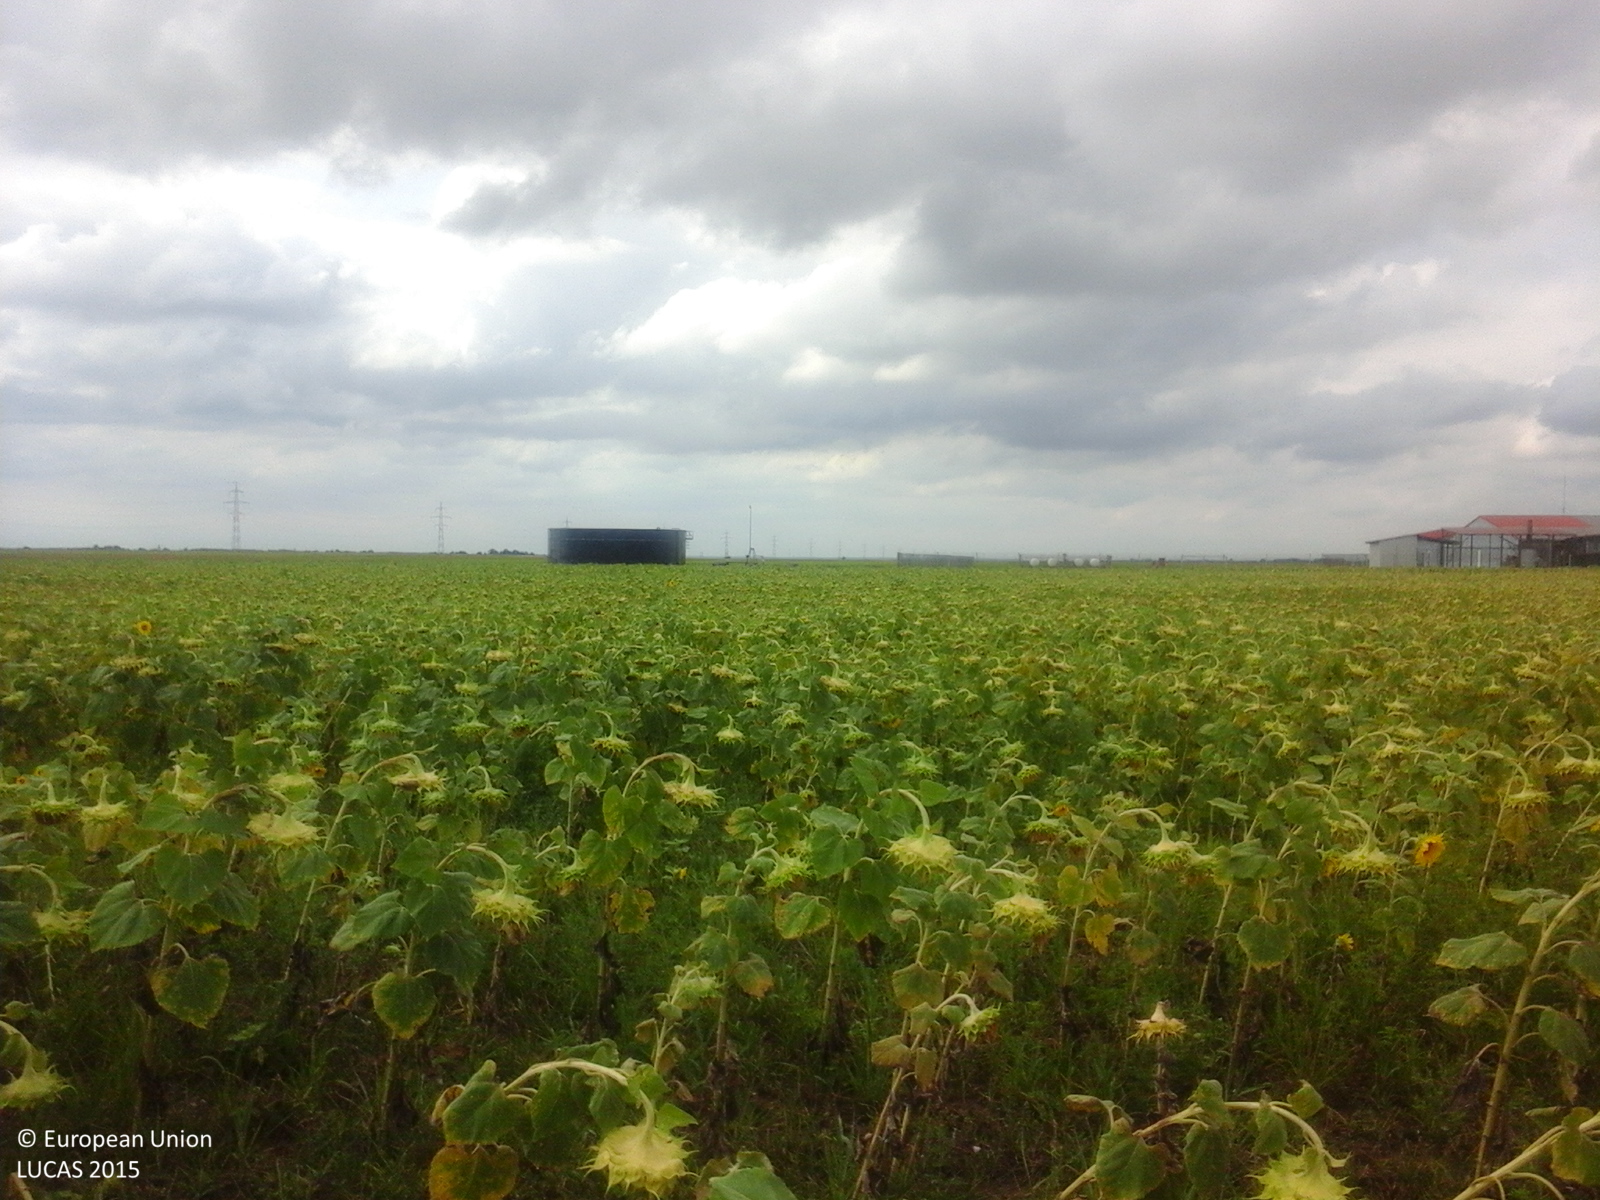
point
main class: Cropland
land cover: Sunflower
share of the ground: > 75 %
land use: Agriculture (excluding fallow land and kitchen gardens)
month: August
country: RO
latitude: 45.5528
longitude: 21.4453
